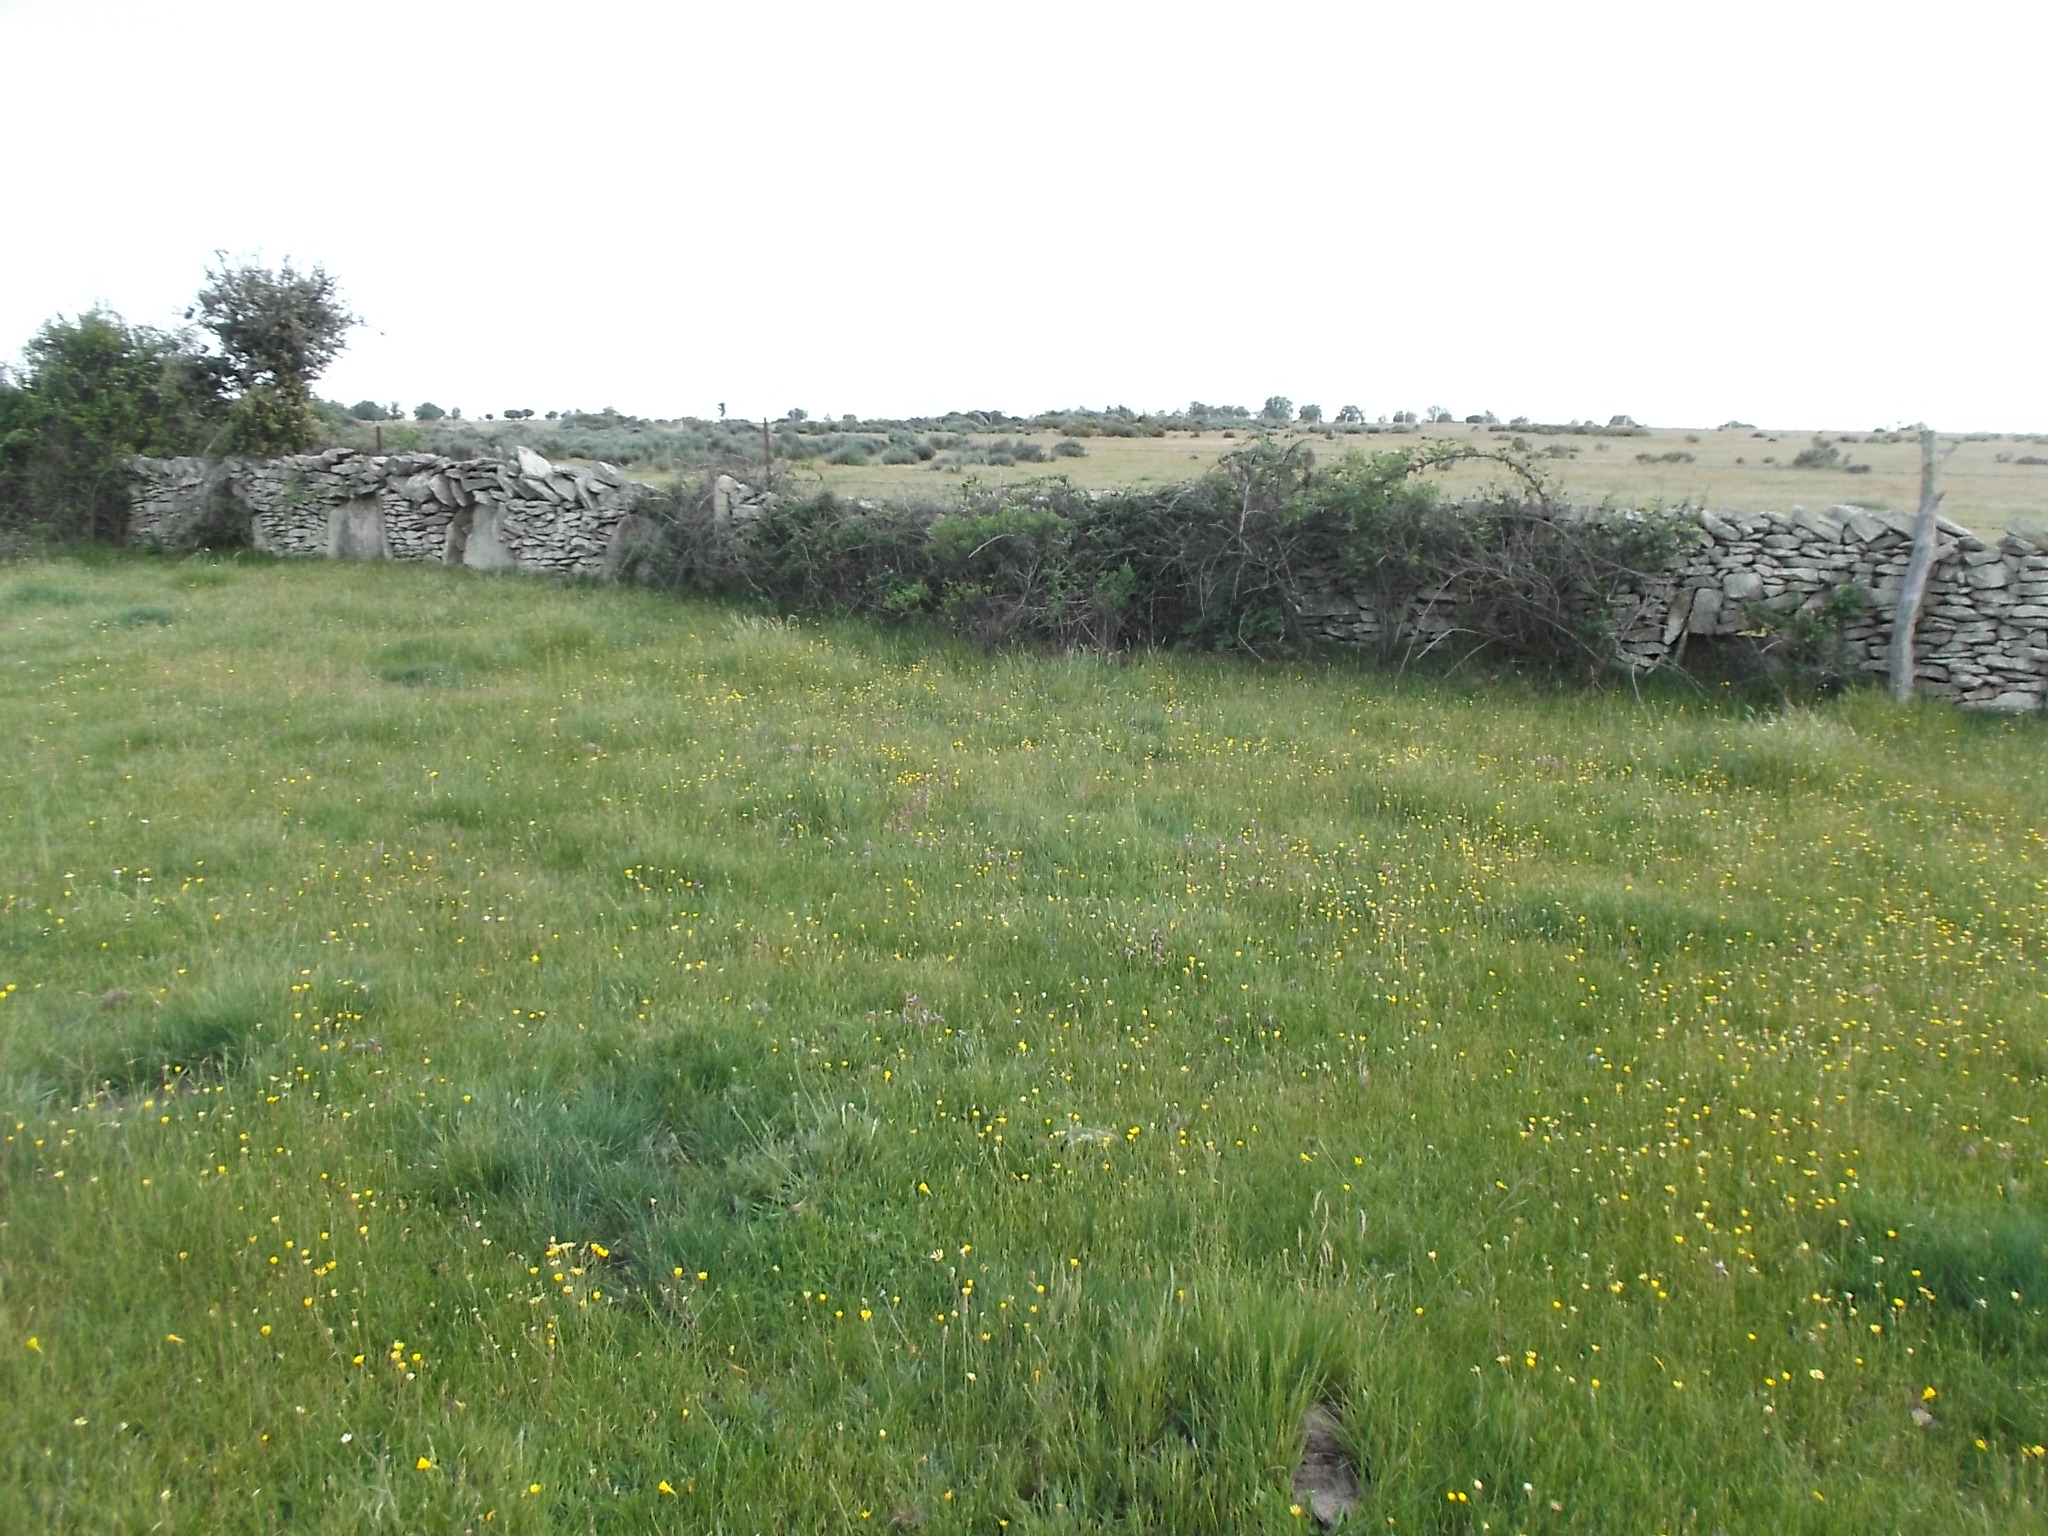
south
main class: Grassland
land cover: Grassland without tree/shrub cover
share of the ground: > 75 %
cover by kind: herbaceous plants 100 %
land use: Agriculture (excluding fallow land and kitchen gardens)
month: May
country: ES
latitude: 41.1557
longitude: -6.3119
